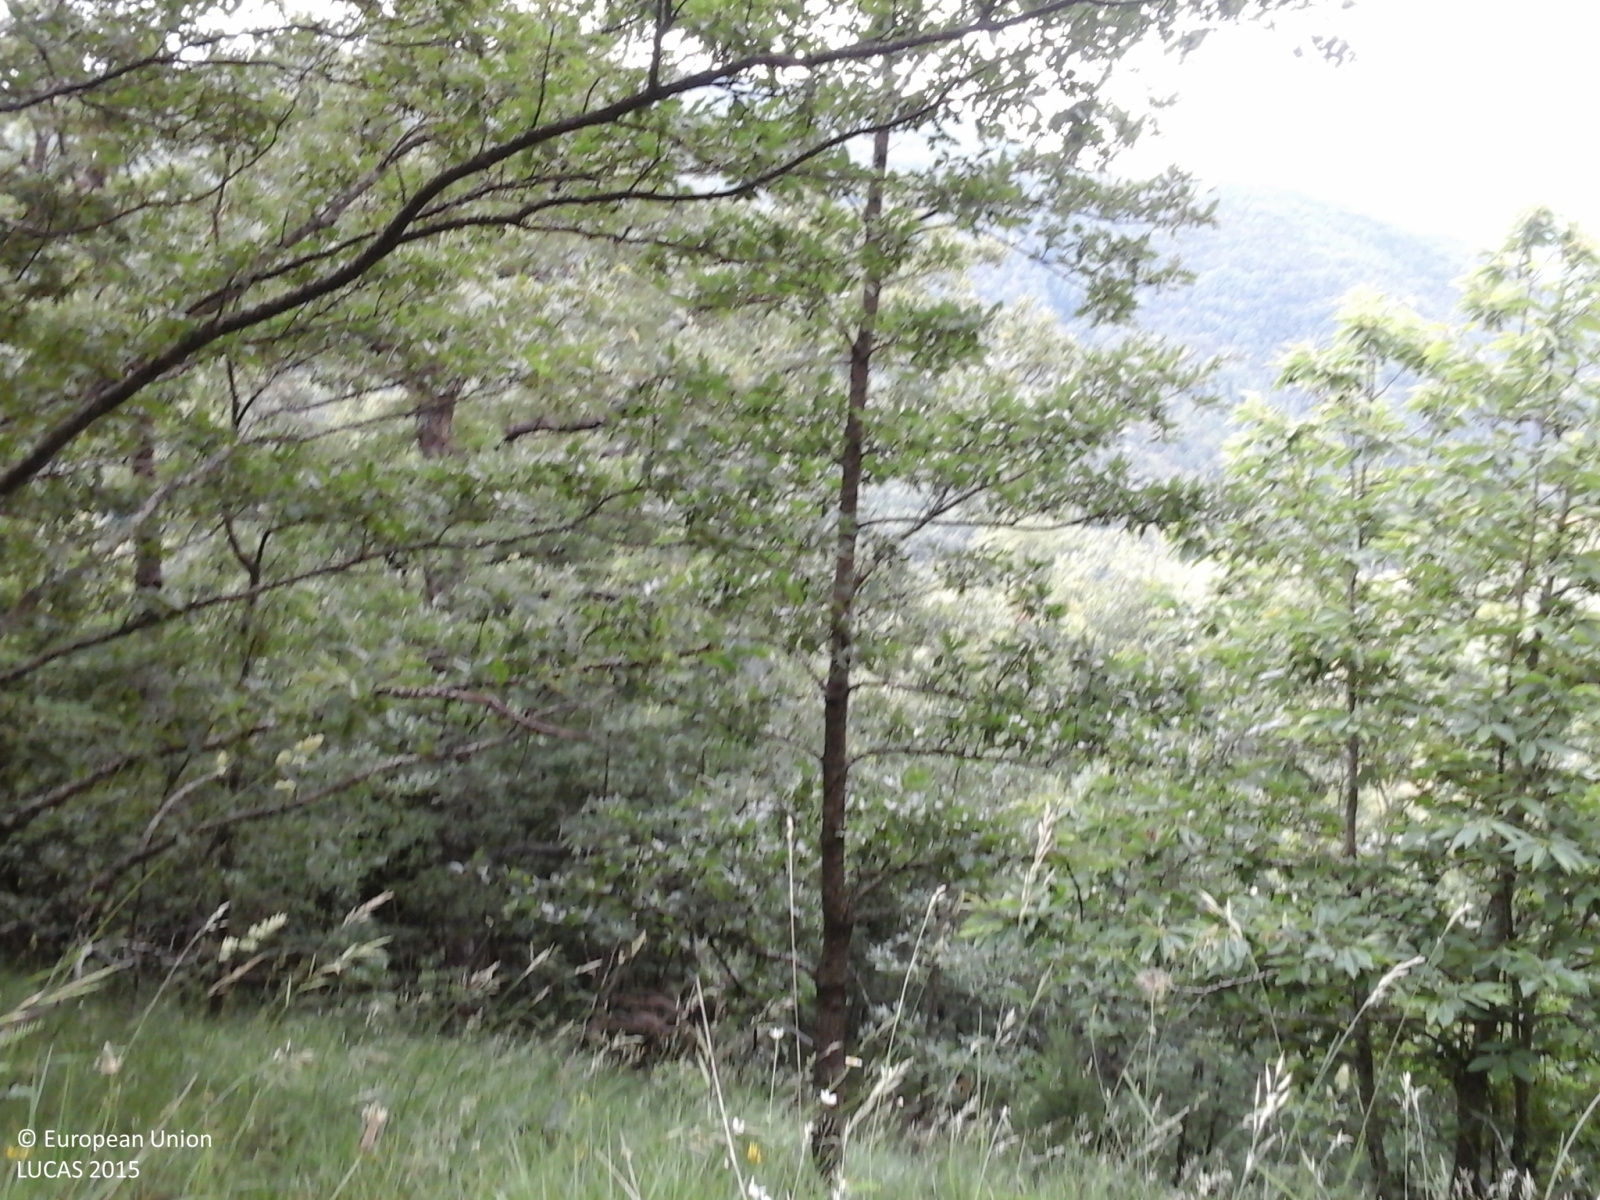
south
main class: Woodland
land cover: Broadleaved woodland
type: thermophilous deciduous forest
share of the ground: > 75 %
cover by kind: broadleaved forest trees 80 %, coniferous forest trees 10 %, shrubs 10 %
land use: Forestry
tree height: > 5 m
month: June
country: IT
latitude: 43.7919
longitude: 11.8966
